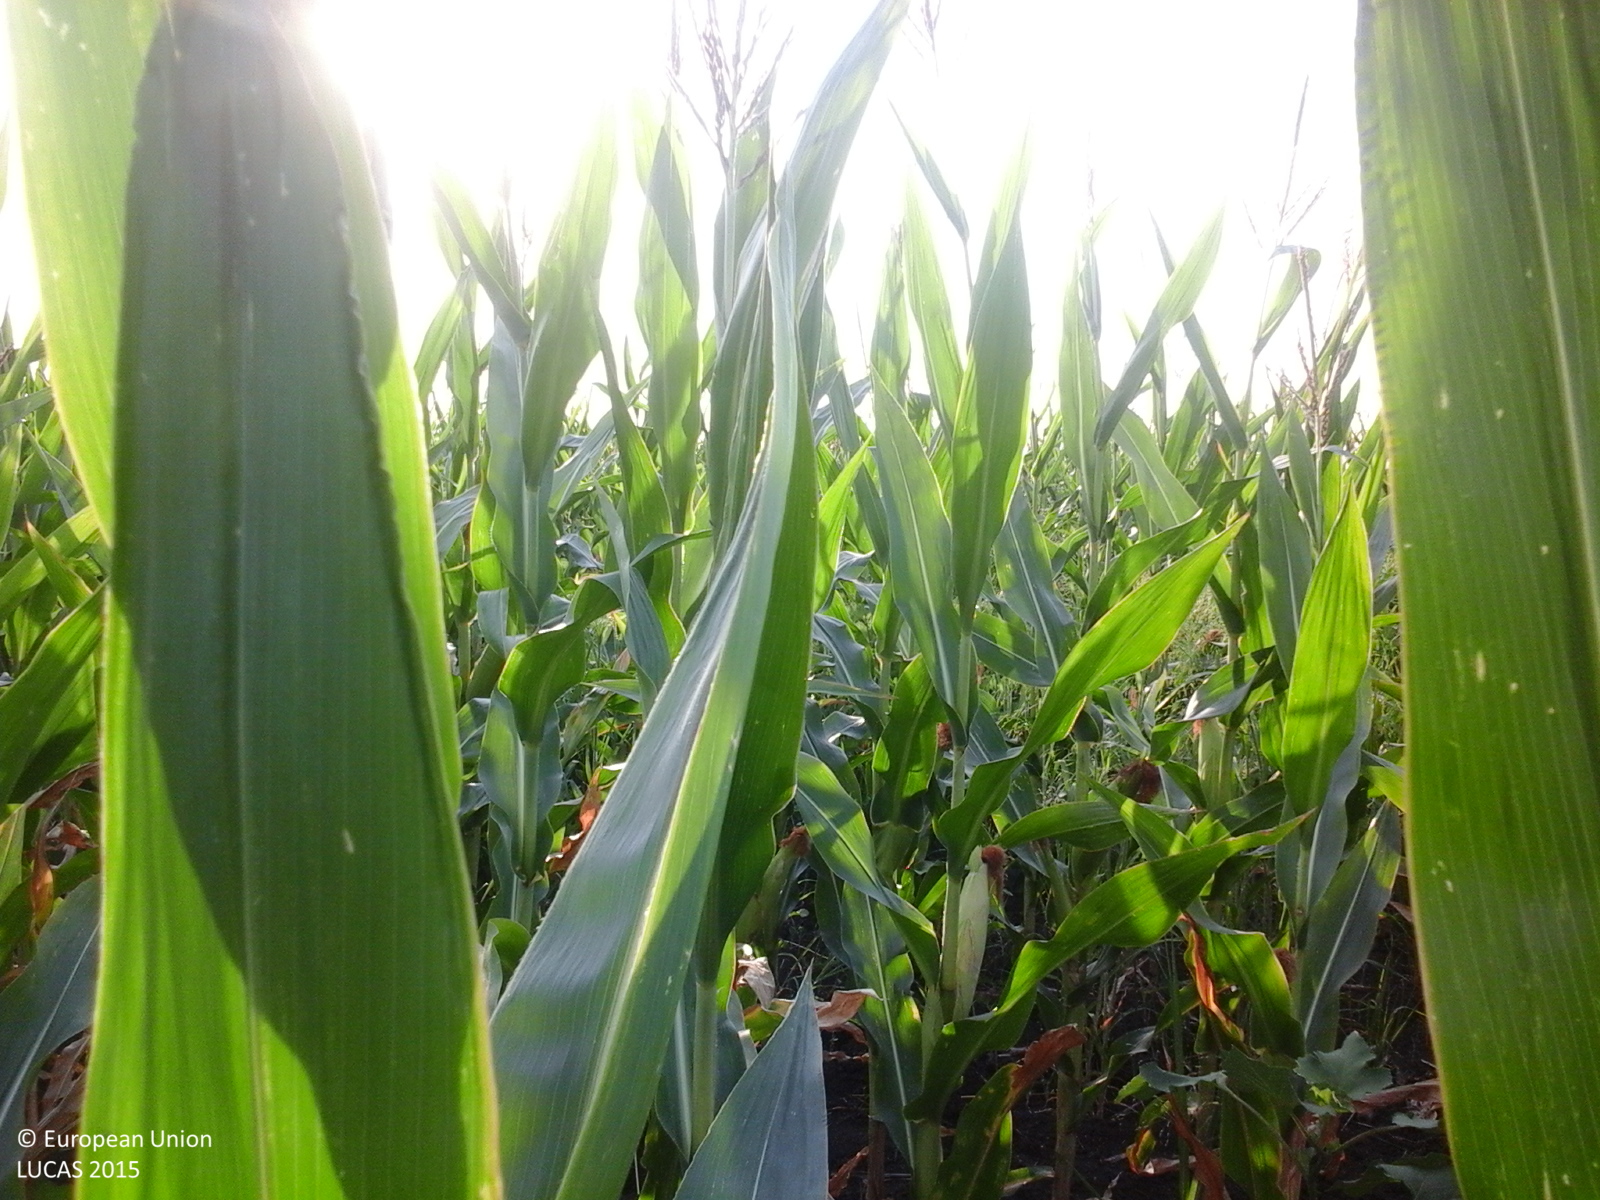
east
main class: Cropland
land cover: Maize
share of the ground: > 75 %
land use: Agriculture (excluding fallow land and kitchen gardens)
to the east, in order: Maize; Tracks; Common wheat; Tracks; Common wheat
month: July
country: RO
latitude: 46.2181
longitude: 28.0543
